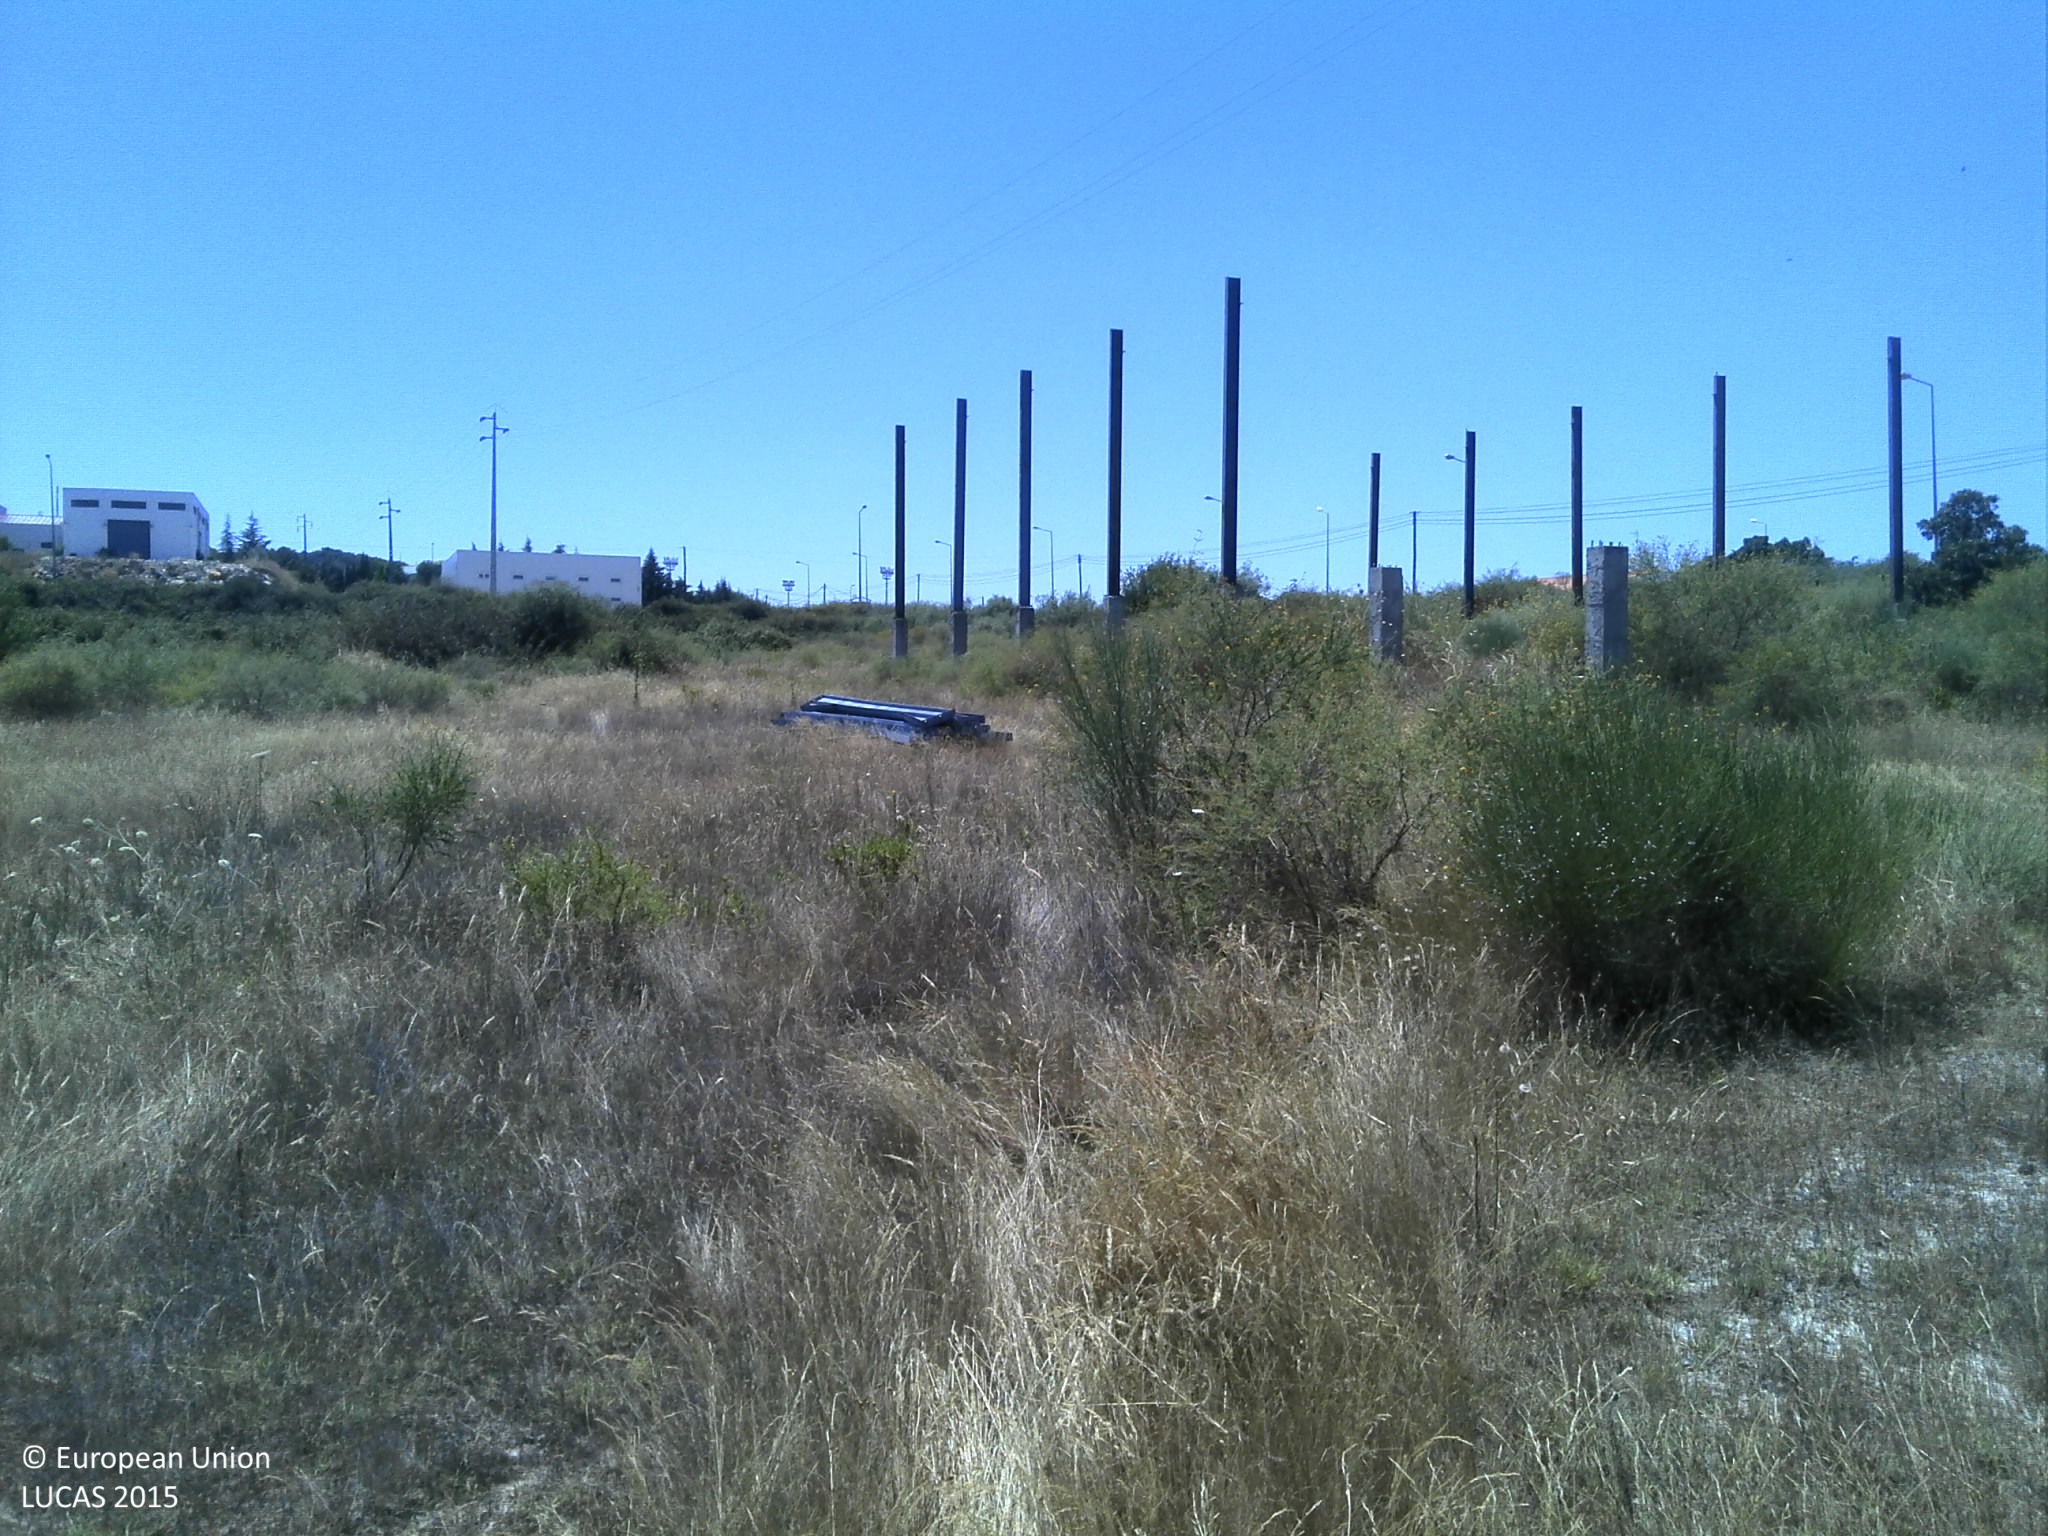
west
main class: Grassland
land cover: Grassland without tree/shrub cover
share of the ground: 50 - 75 %
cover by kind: herbaceous plants 75 %, unconsolidated bare surface 15 %
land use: Agriculture (excluding fallow land and kitchen gardens)
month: June
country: PT
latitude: 39.9455
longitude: -7.2415
